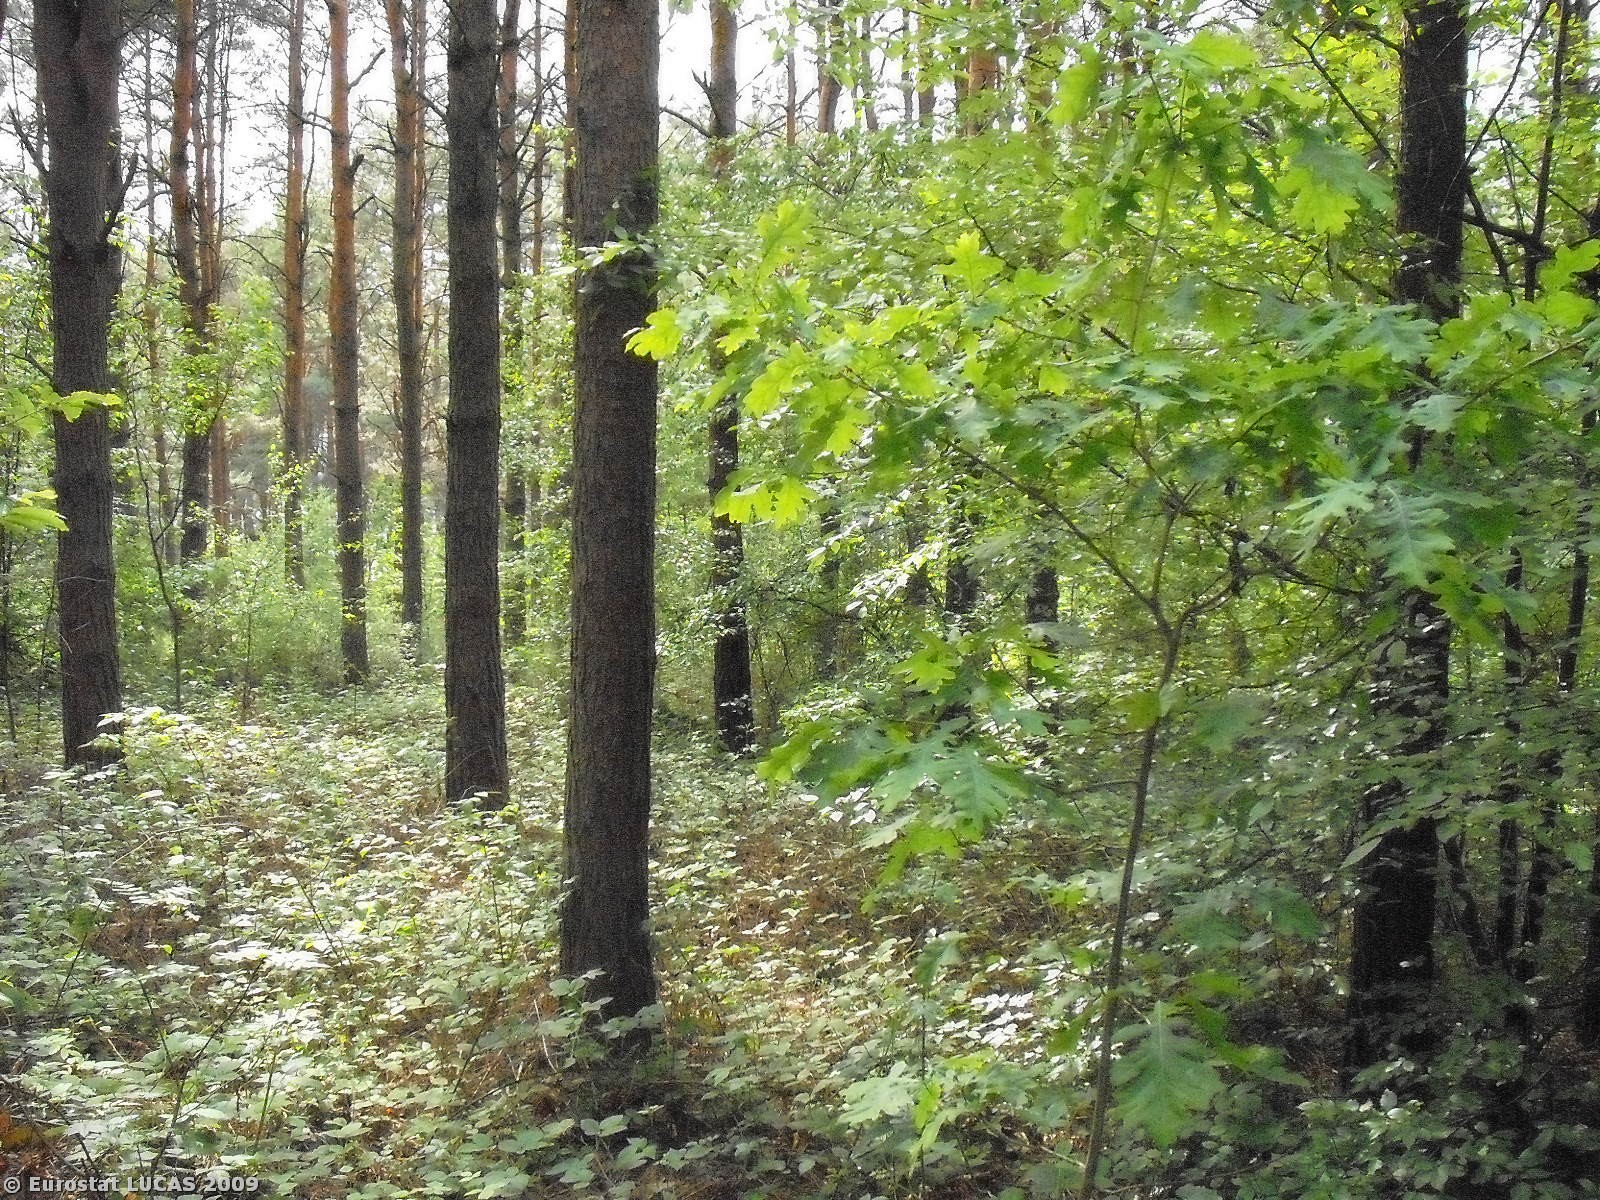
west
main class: Woodland
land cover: Mixed woodland
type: hemiboreal forest and nemoral coniferous forest and mixed broadleaved-coniferous forest
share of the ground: > 75 %
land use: Forestry
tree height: > 5 m
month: June
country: PL
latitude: 51.2073
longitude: 20.8494
